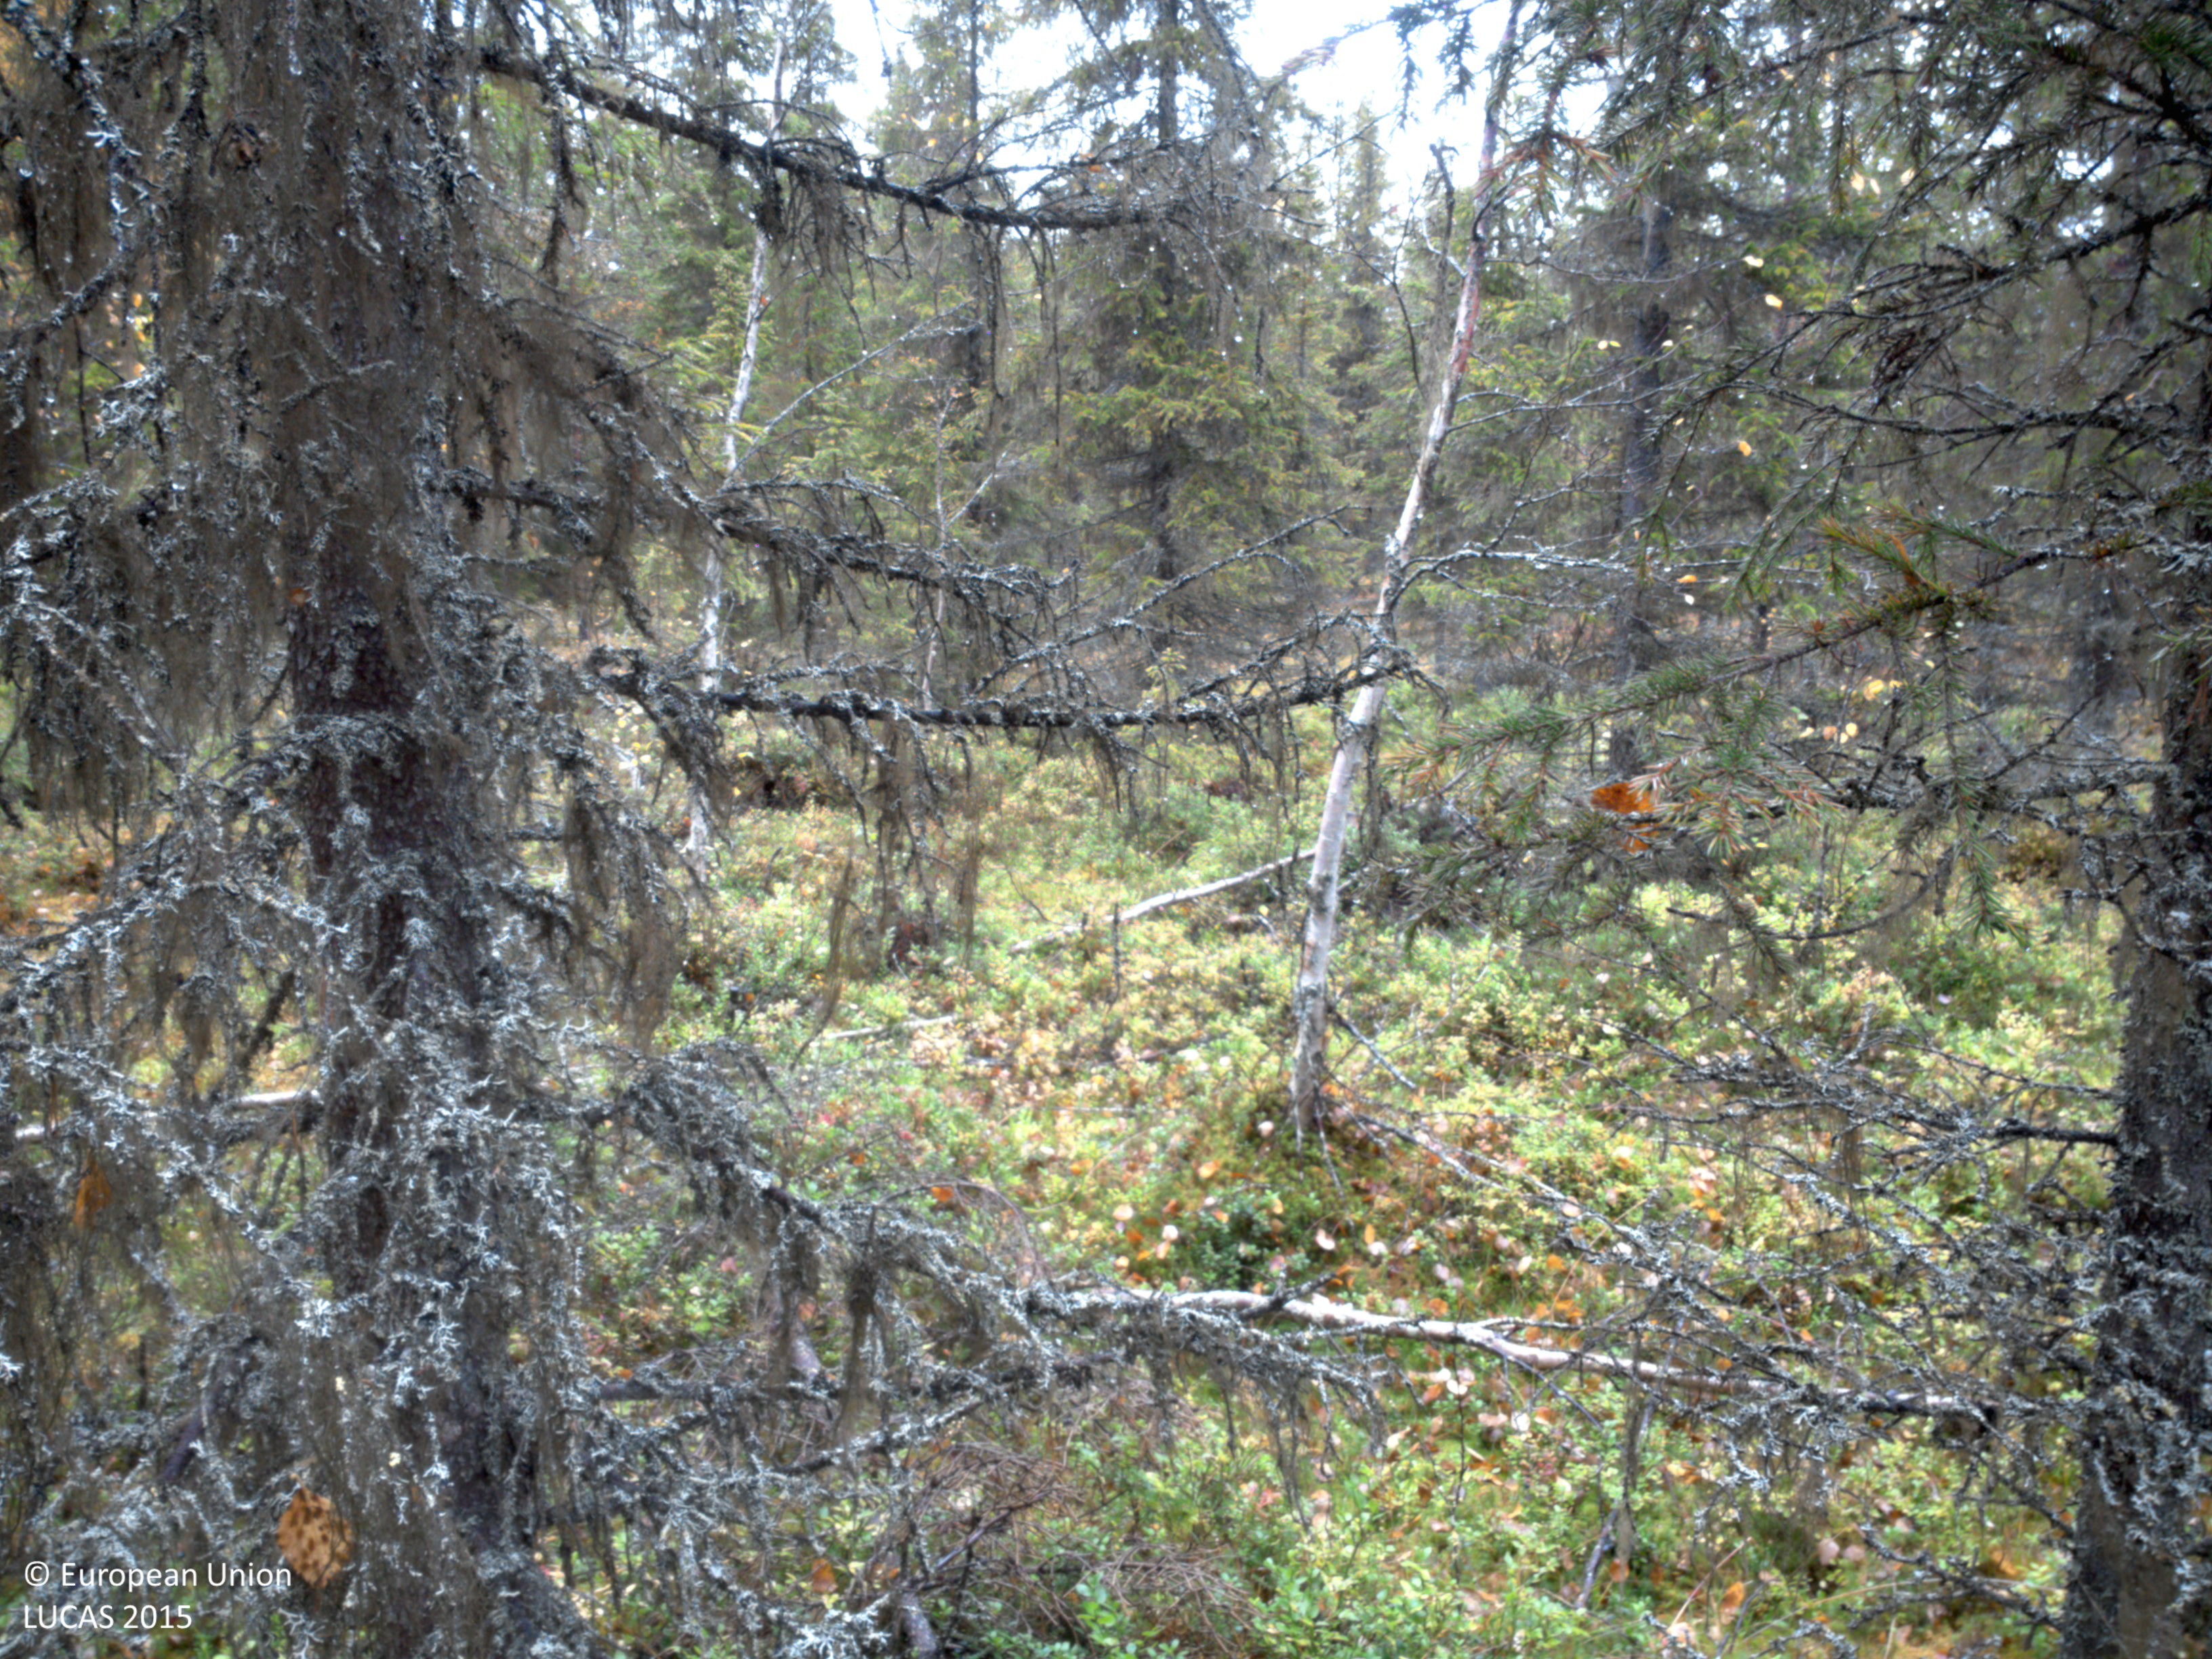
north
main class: Woodland
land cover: Spruce dominated mixed woodland
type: boreal forest
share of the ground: > 75 %
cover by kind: coniferous forest trees 55 %, broadleaved forest trees 25 %, shrubs 10 %, herbaceous plants 5 %, lichens and mosses 5 %
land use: Forestry
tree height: > 5 m
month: September
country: SE
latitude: 64.9967
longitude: 19.0196
